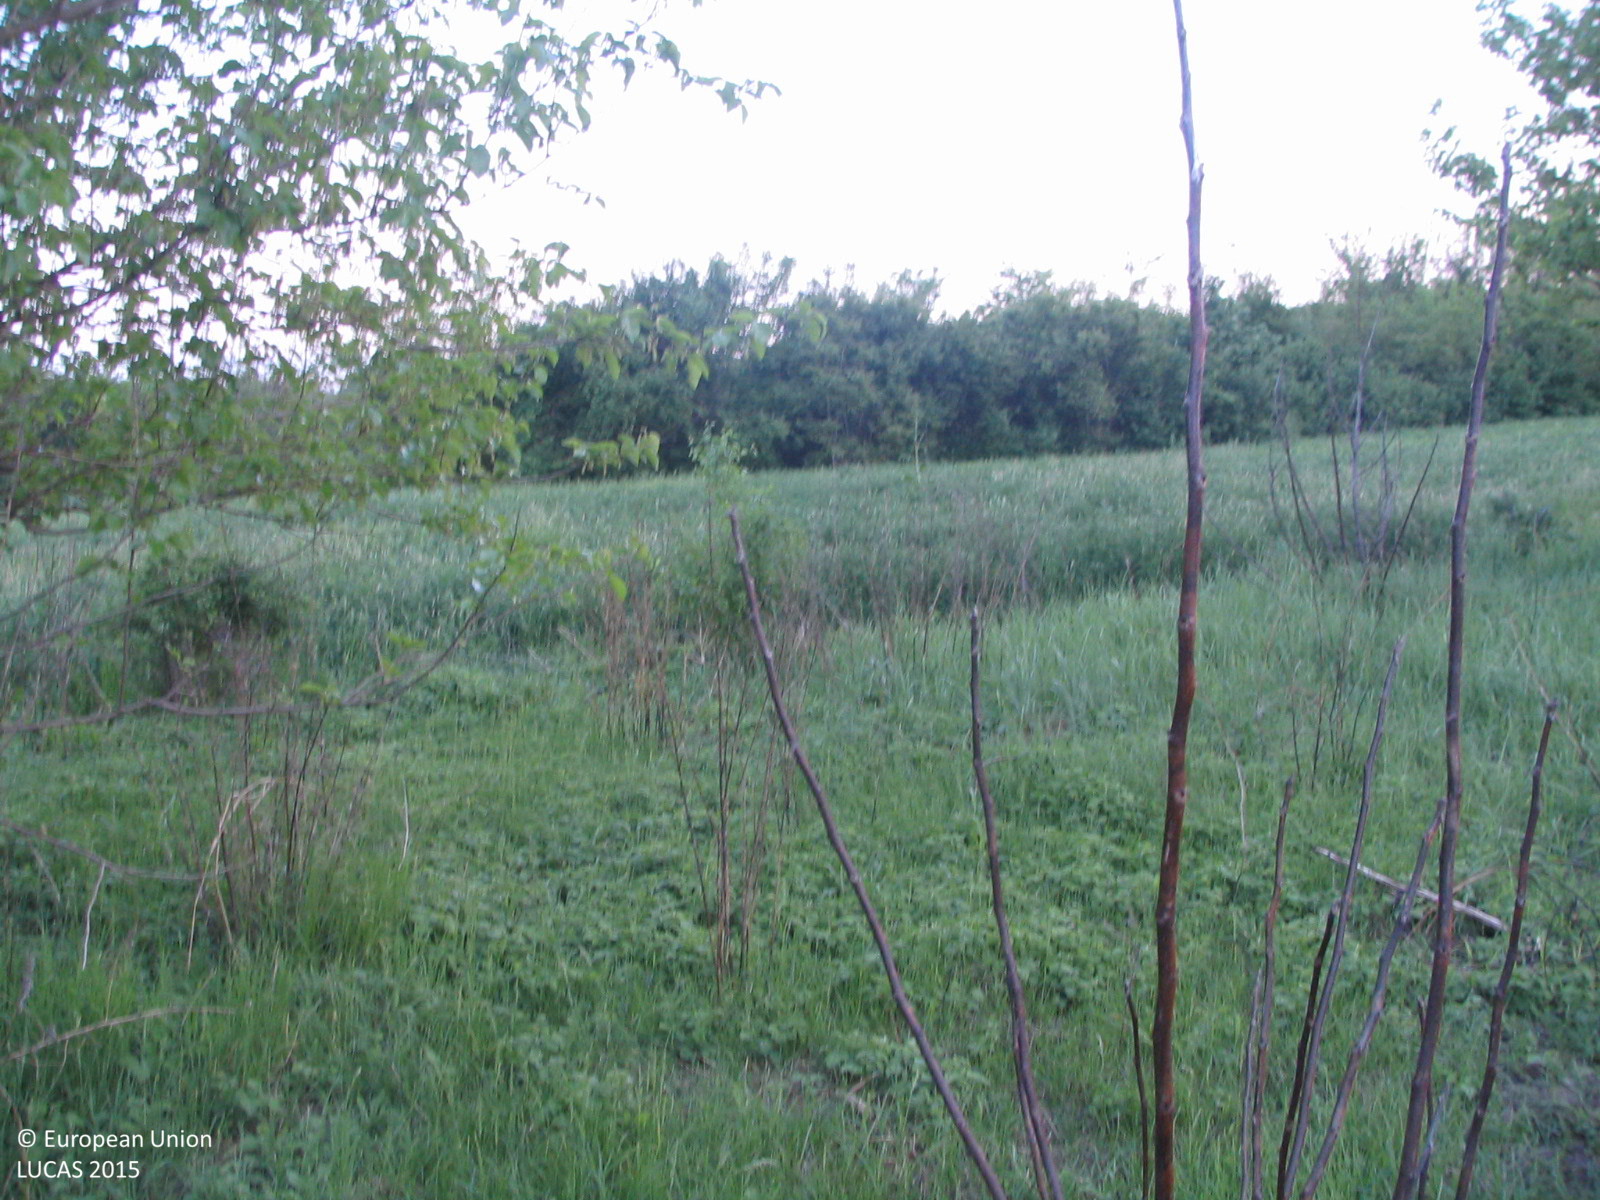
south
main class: Grassland
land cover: Grassland with sparse tree/shrub cover
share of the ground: > 75 %
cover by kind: herbaceous plants 90 %, broadleaved forest trees 5 %, shrubs 5 %
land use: Abandoned areas
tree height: > 5 m
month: May
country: BG
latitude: 43.6363
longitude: 23.8476
